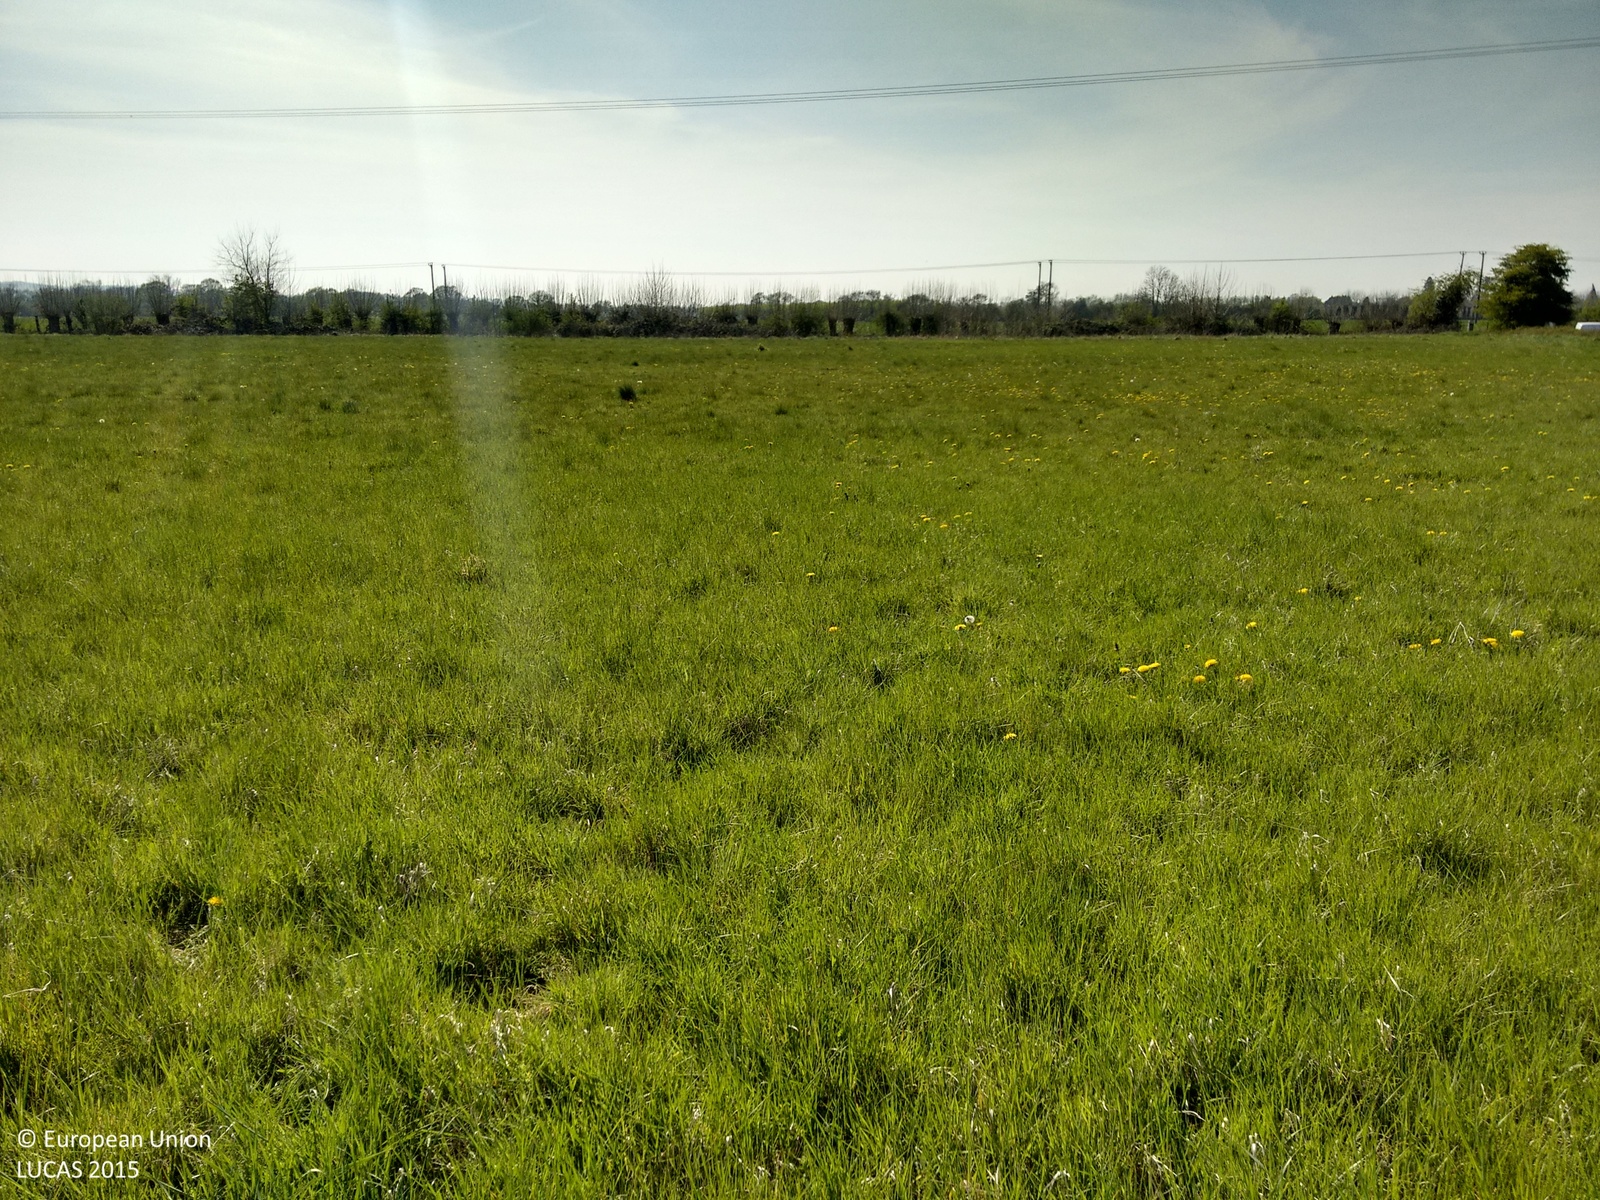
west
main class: Grassland
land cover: Grassland without tree/shrub cover
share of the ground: > 75 %
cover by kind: herbaceous plants 100 %
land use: Agriculture (excluding fallow land and kitchen gardens)
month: April
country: GB
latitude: 51.2062
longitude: 0.3666
